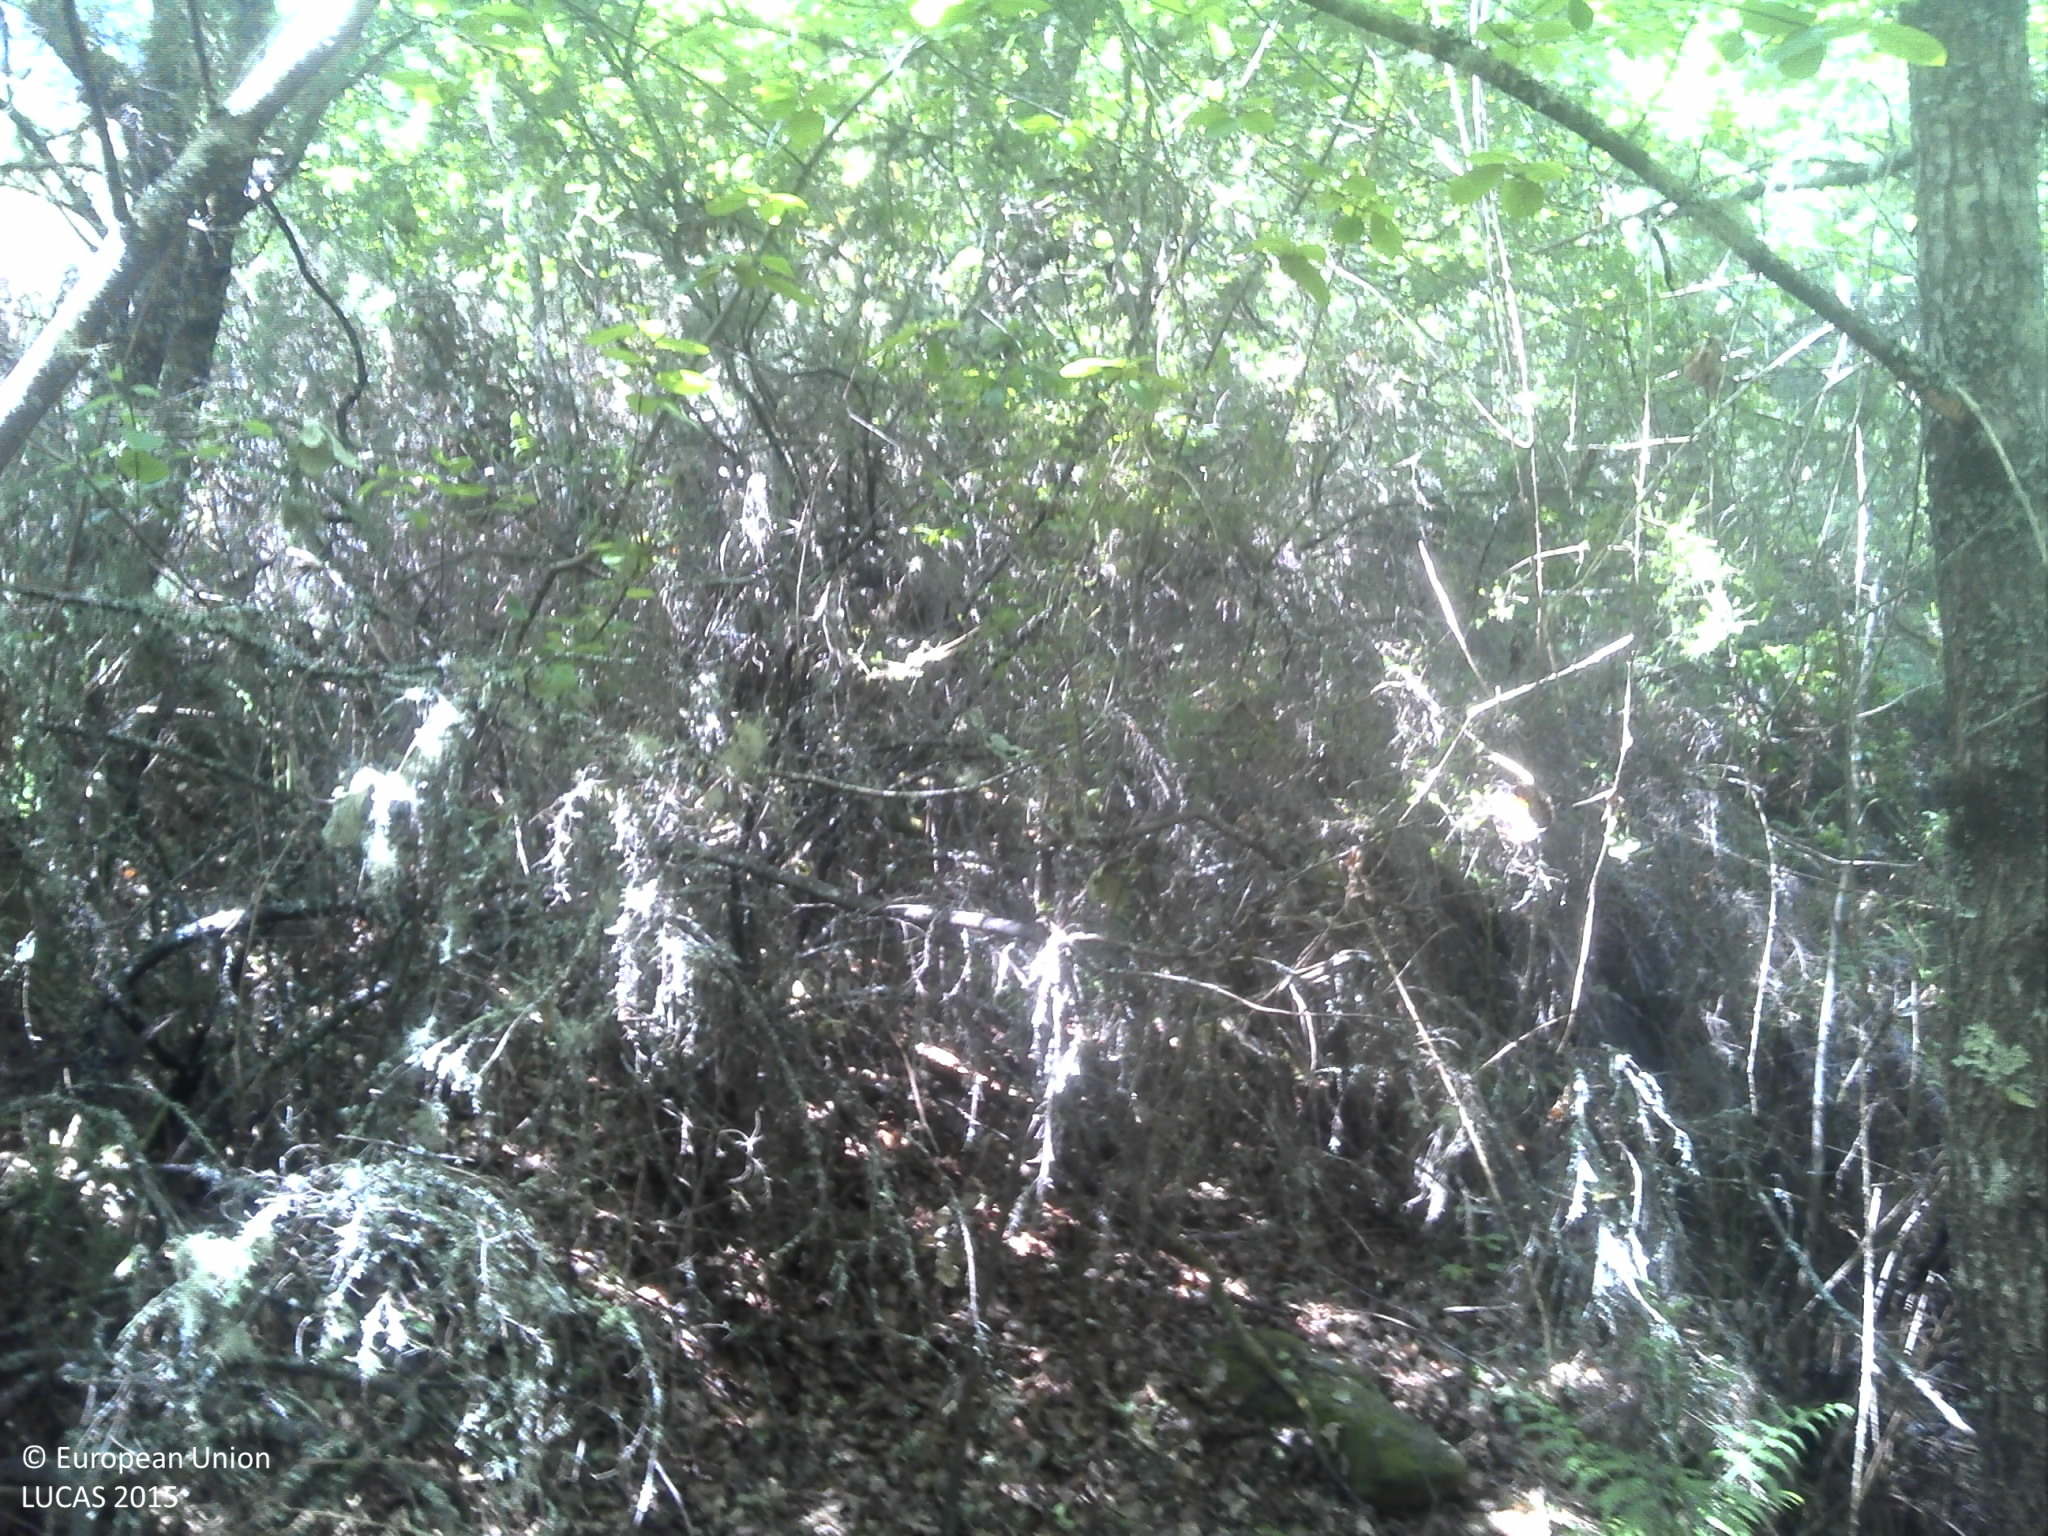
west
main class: Woodland
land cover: Broadleaved woodland
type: acidophilous oak and oak-birch forest
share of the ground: > 75 %
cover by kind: broadleaved forest trees 80 %, coniferous forest trees 10 %, shrubs 10 %
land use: Forestry
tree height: > 5 m
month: May
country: PT
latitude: 40.7040
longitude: -7.8413
